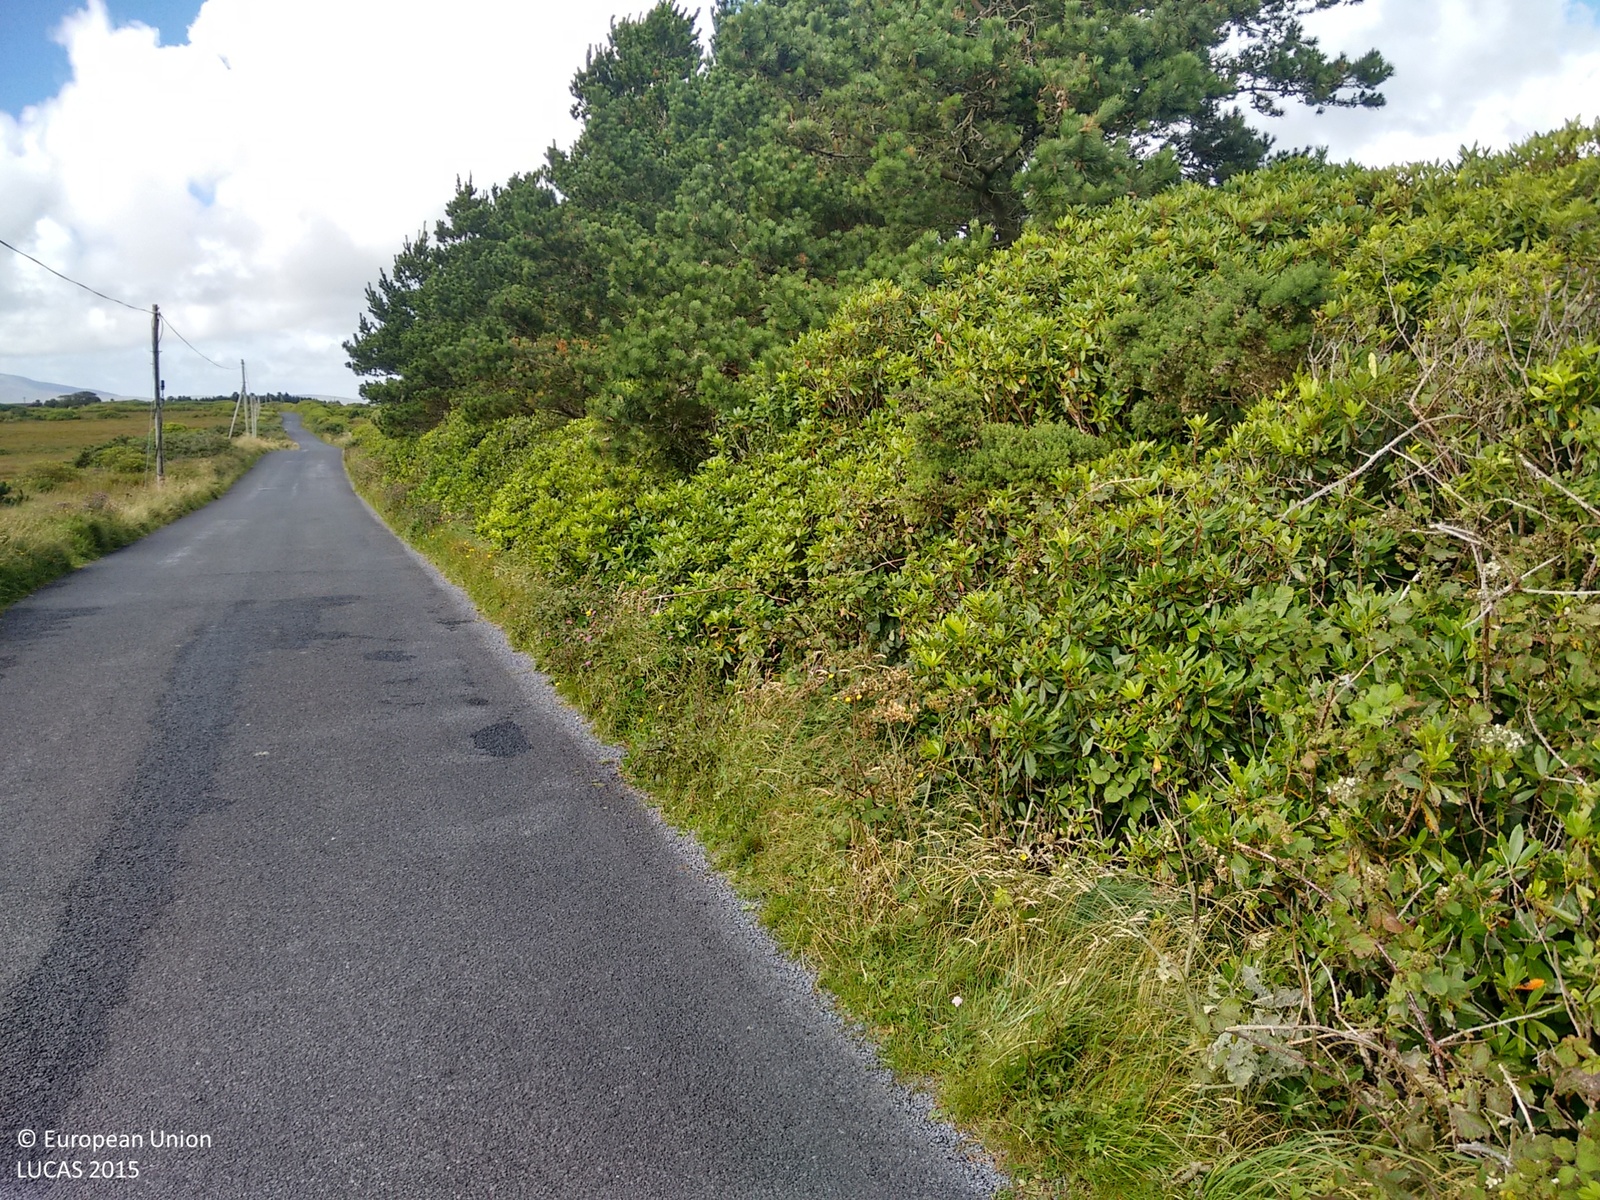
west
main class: Shrubland
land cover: Shrubland with sparse tree cover
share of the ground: 50 - 75 %
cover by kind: shrubs 35 %, herbaceous plants 20 %, lichens and mosses 20 %, consolidated bare surface 20 %, coniferous forest trees 5 %
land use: Semi-natural and natural areas not in use
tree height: > 5 m
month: August
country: IE
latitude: 54.0201
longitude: -9.8280
